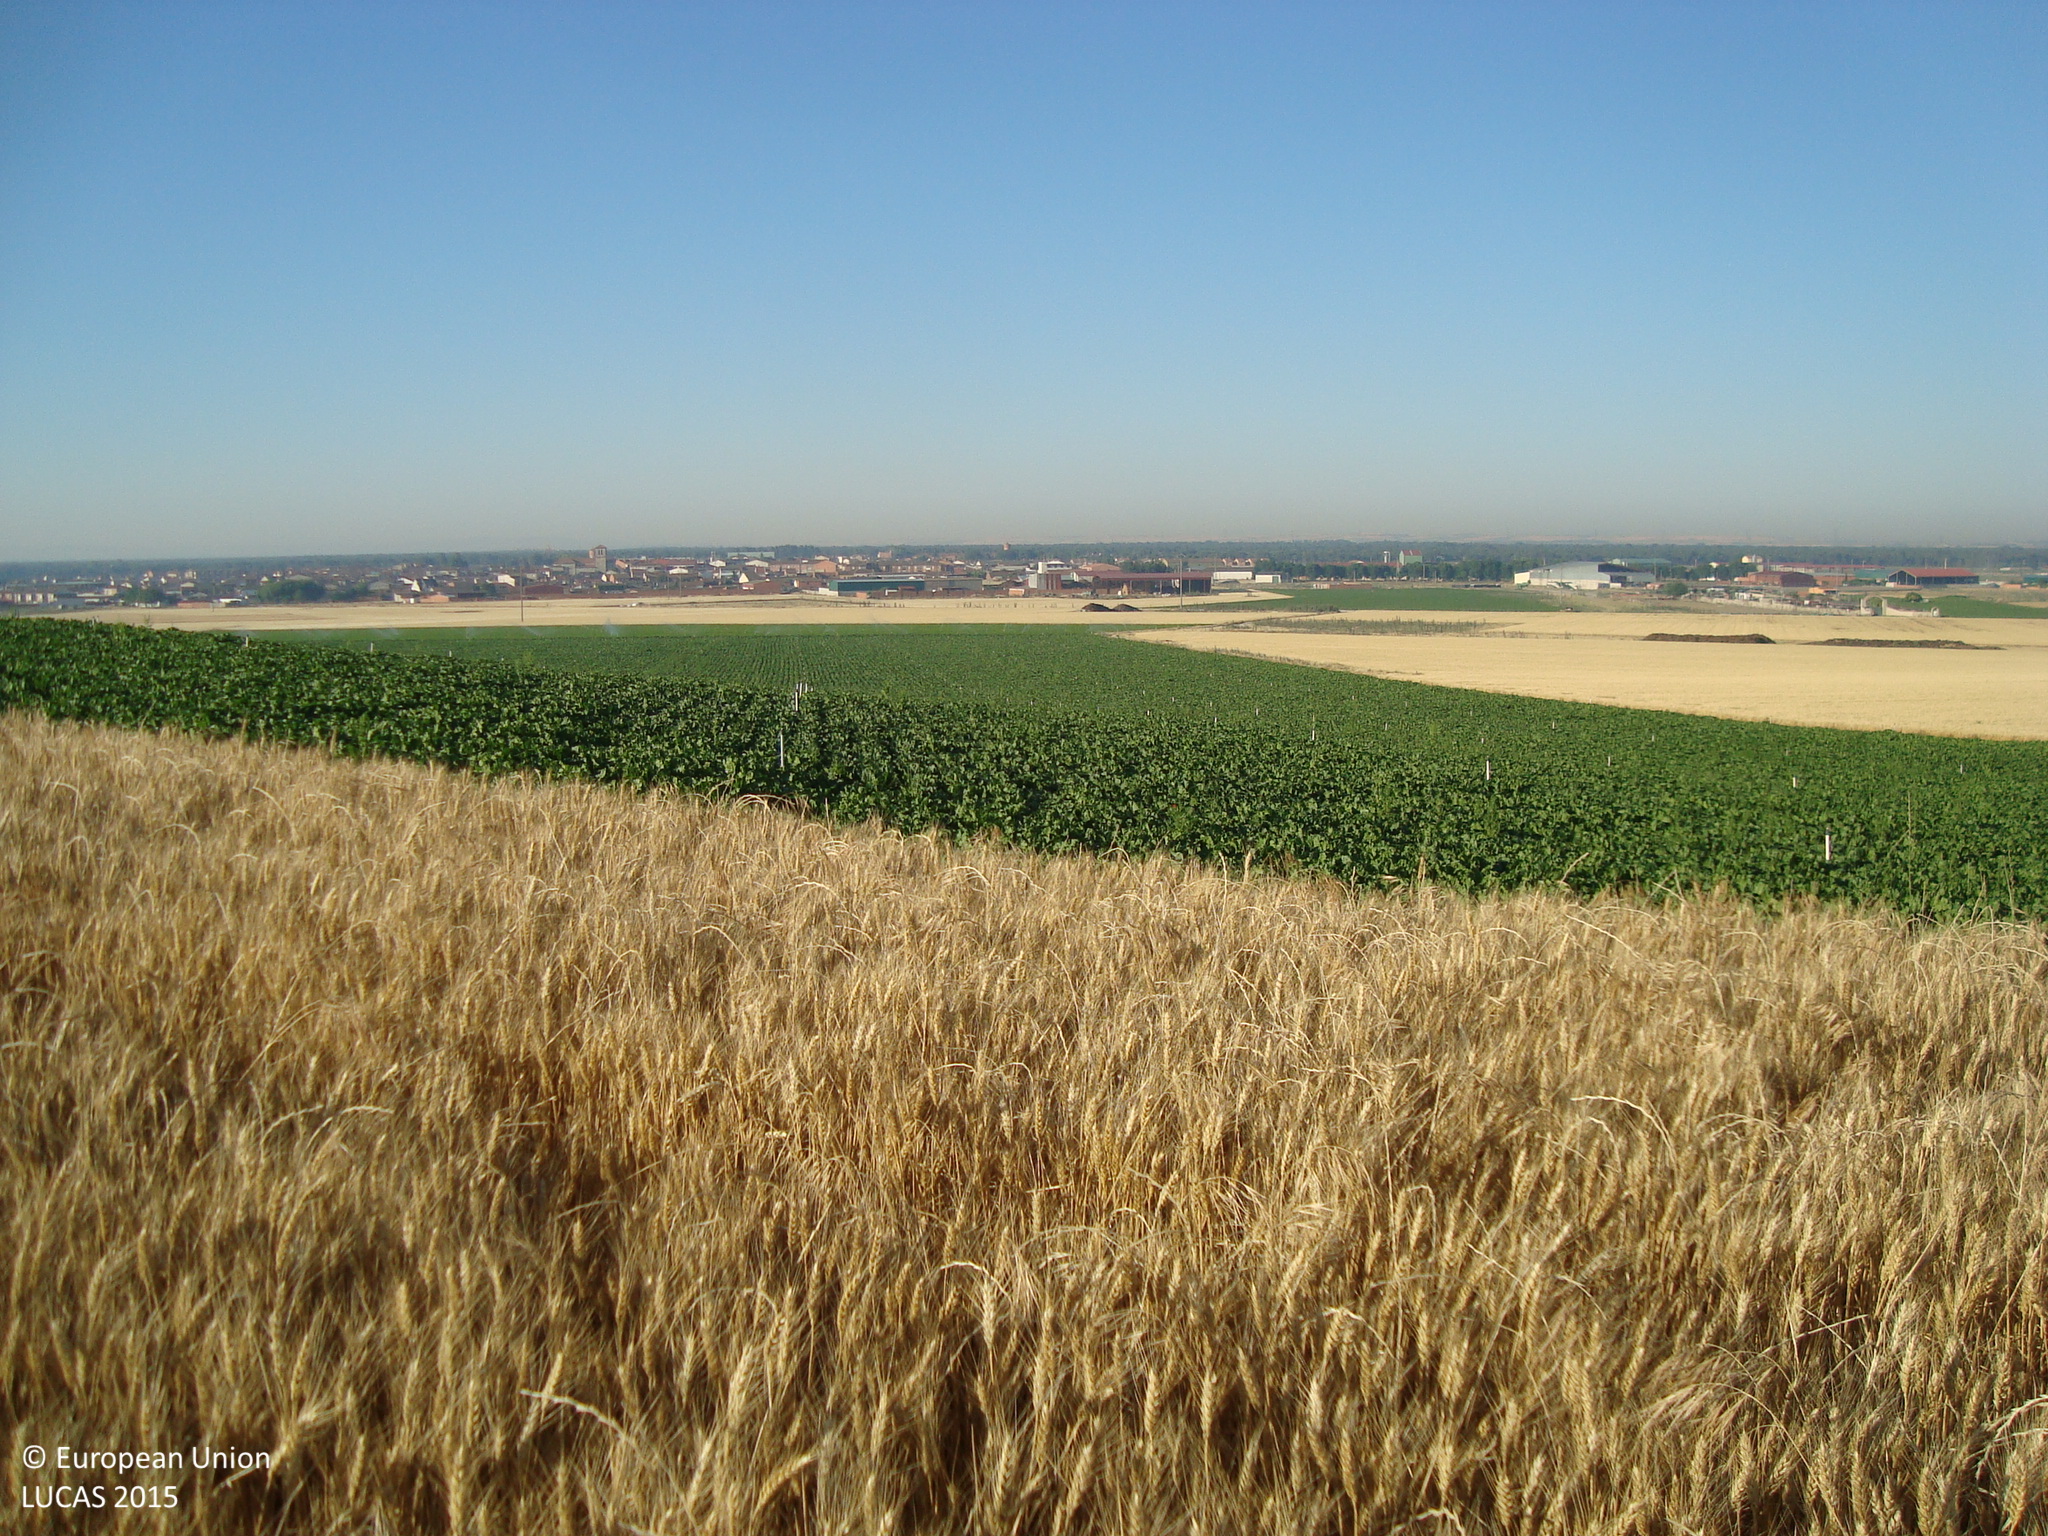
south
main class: Cropland
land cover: Common wheat
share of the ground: > 75 %
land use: Agriculture (excluding fallow land and kitchen gardens)
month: June
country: ES
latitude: 41.3535
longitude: -4.5853
